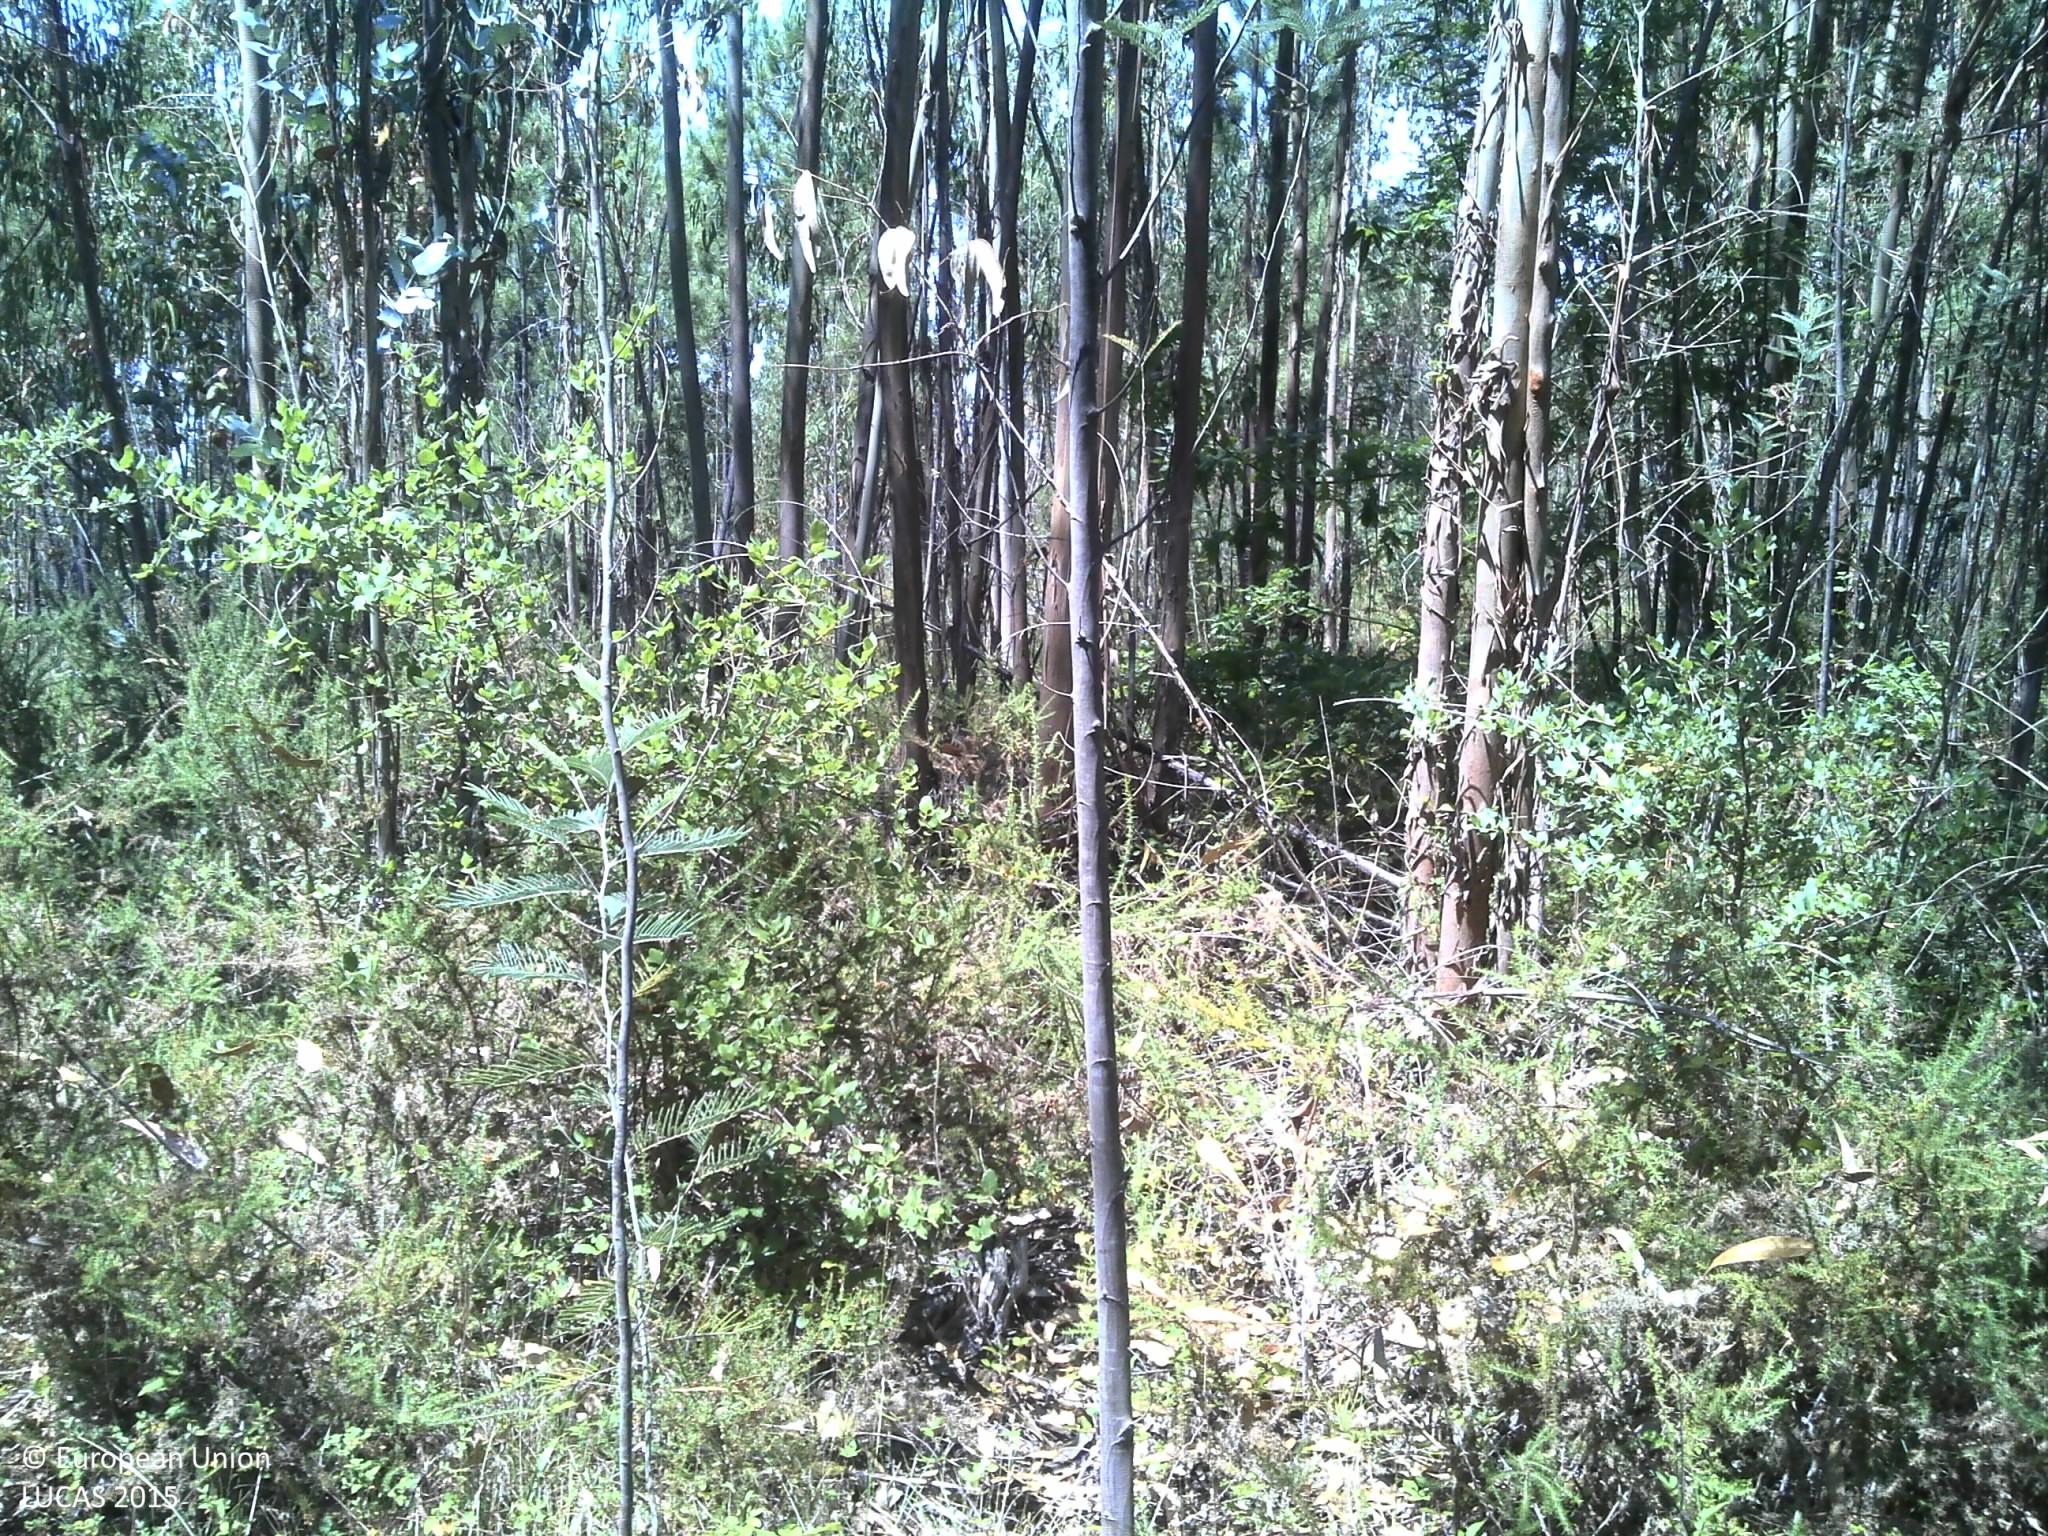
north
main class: Woodland
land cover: Broadleaved woodland
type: exotic forest
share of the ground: > 75 %
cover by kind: broadleaved forest trees 75 %, shrubs 15 %, unconsolidated bare surface 10 %
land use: Forestry
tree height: > 5 m
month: July
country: PT
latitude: 40.2112
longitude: -8.2070
